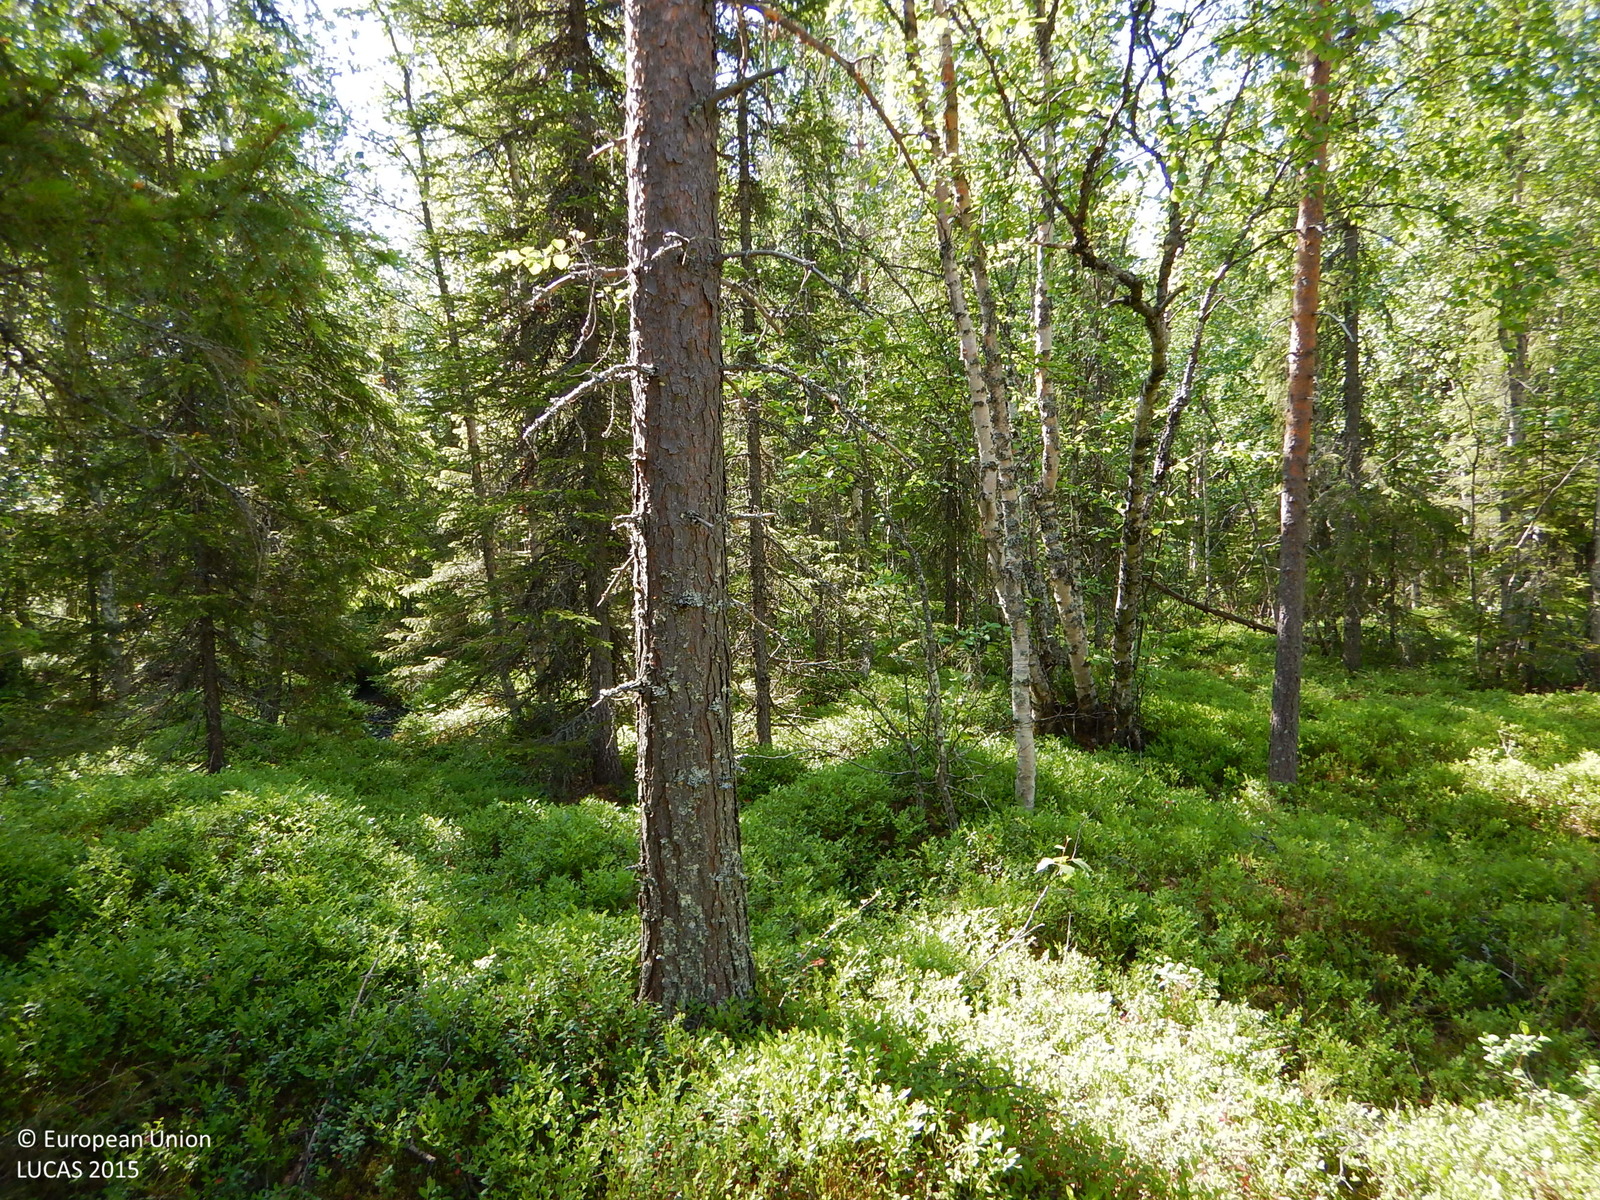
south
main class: Woodland
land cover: Spruce dominated mixed woodland
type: boreal forest
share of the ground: 25 - 50 %
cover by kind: shrubs 30 %, lichens and mosses 25 %, coniferous forest trees 20 %, broadleaved forest trees 15 %, herbaceous plants 10 %
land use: Forestry
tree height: > 5 m
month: July
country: SE
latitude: 65.0954
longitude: 18.5404
